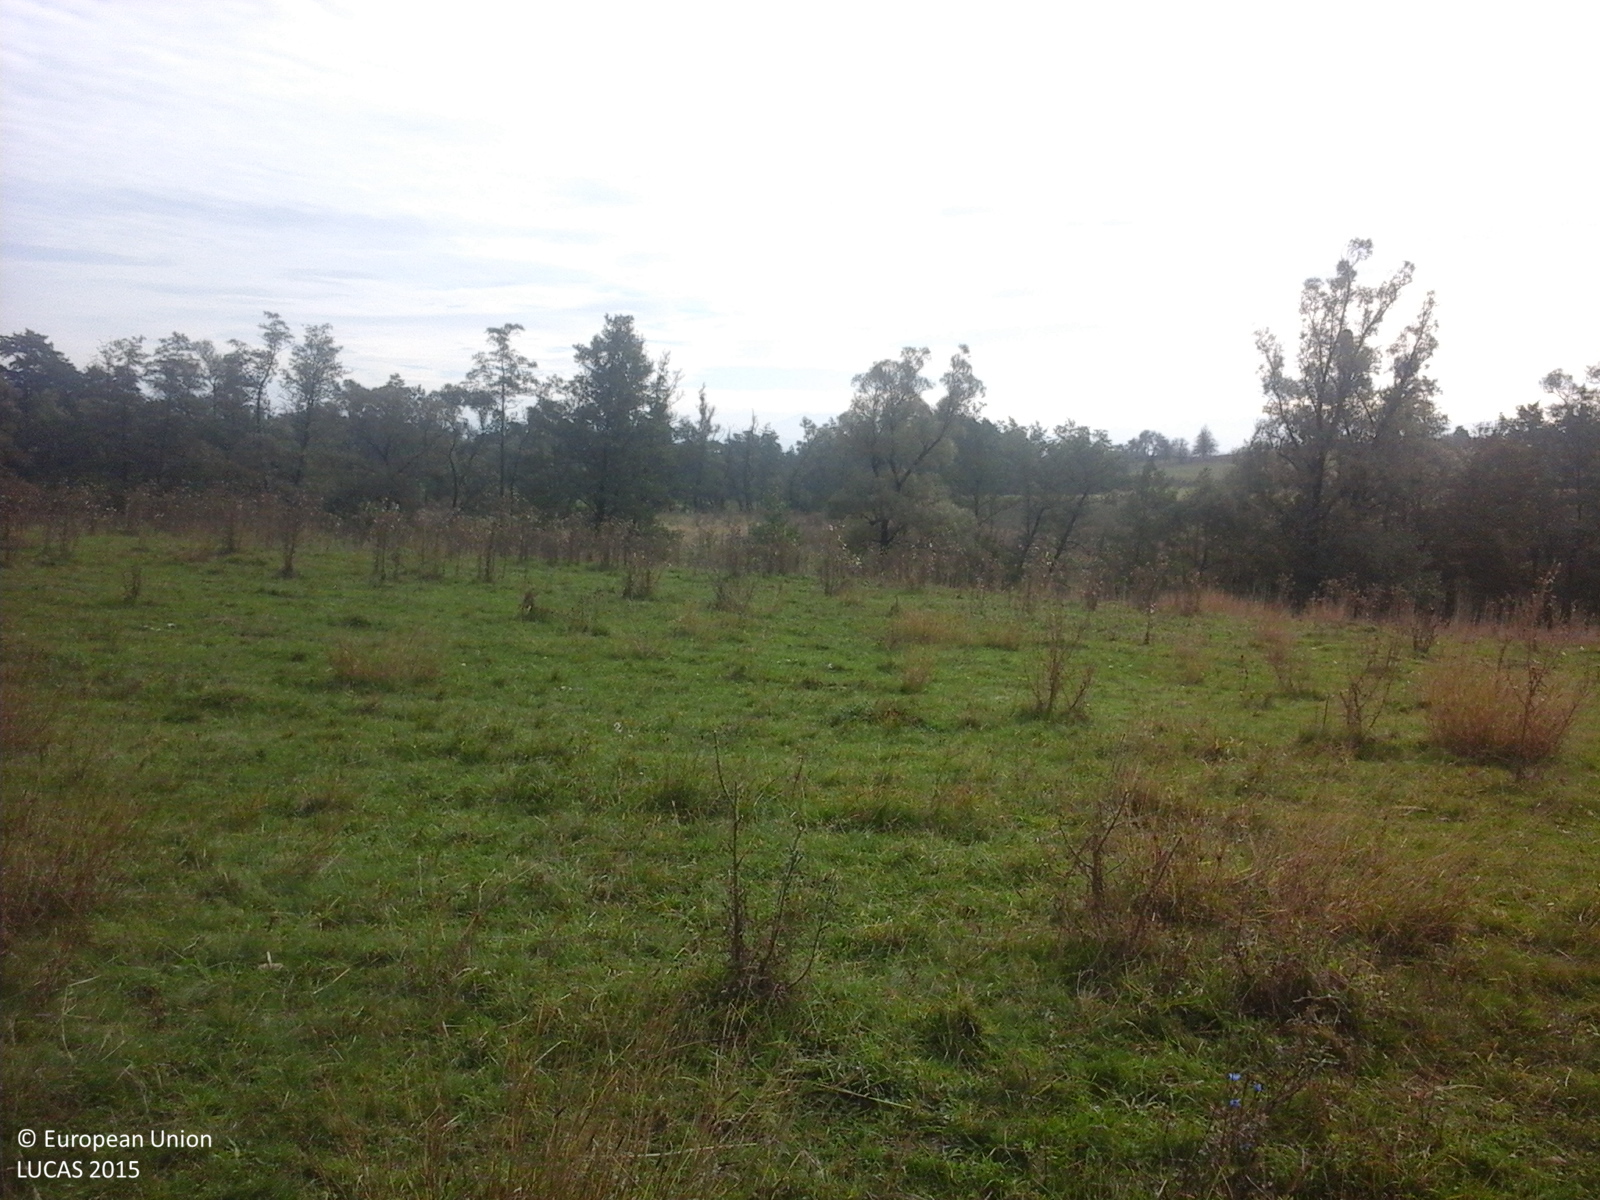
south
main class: Grassland
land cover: Spontaneously vegetated surfaces
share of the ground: > 75 %
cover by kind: herbaceous plants 100 %
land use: Fallow land
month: October
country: RO
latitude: 45.8752
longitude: 25.1043
